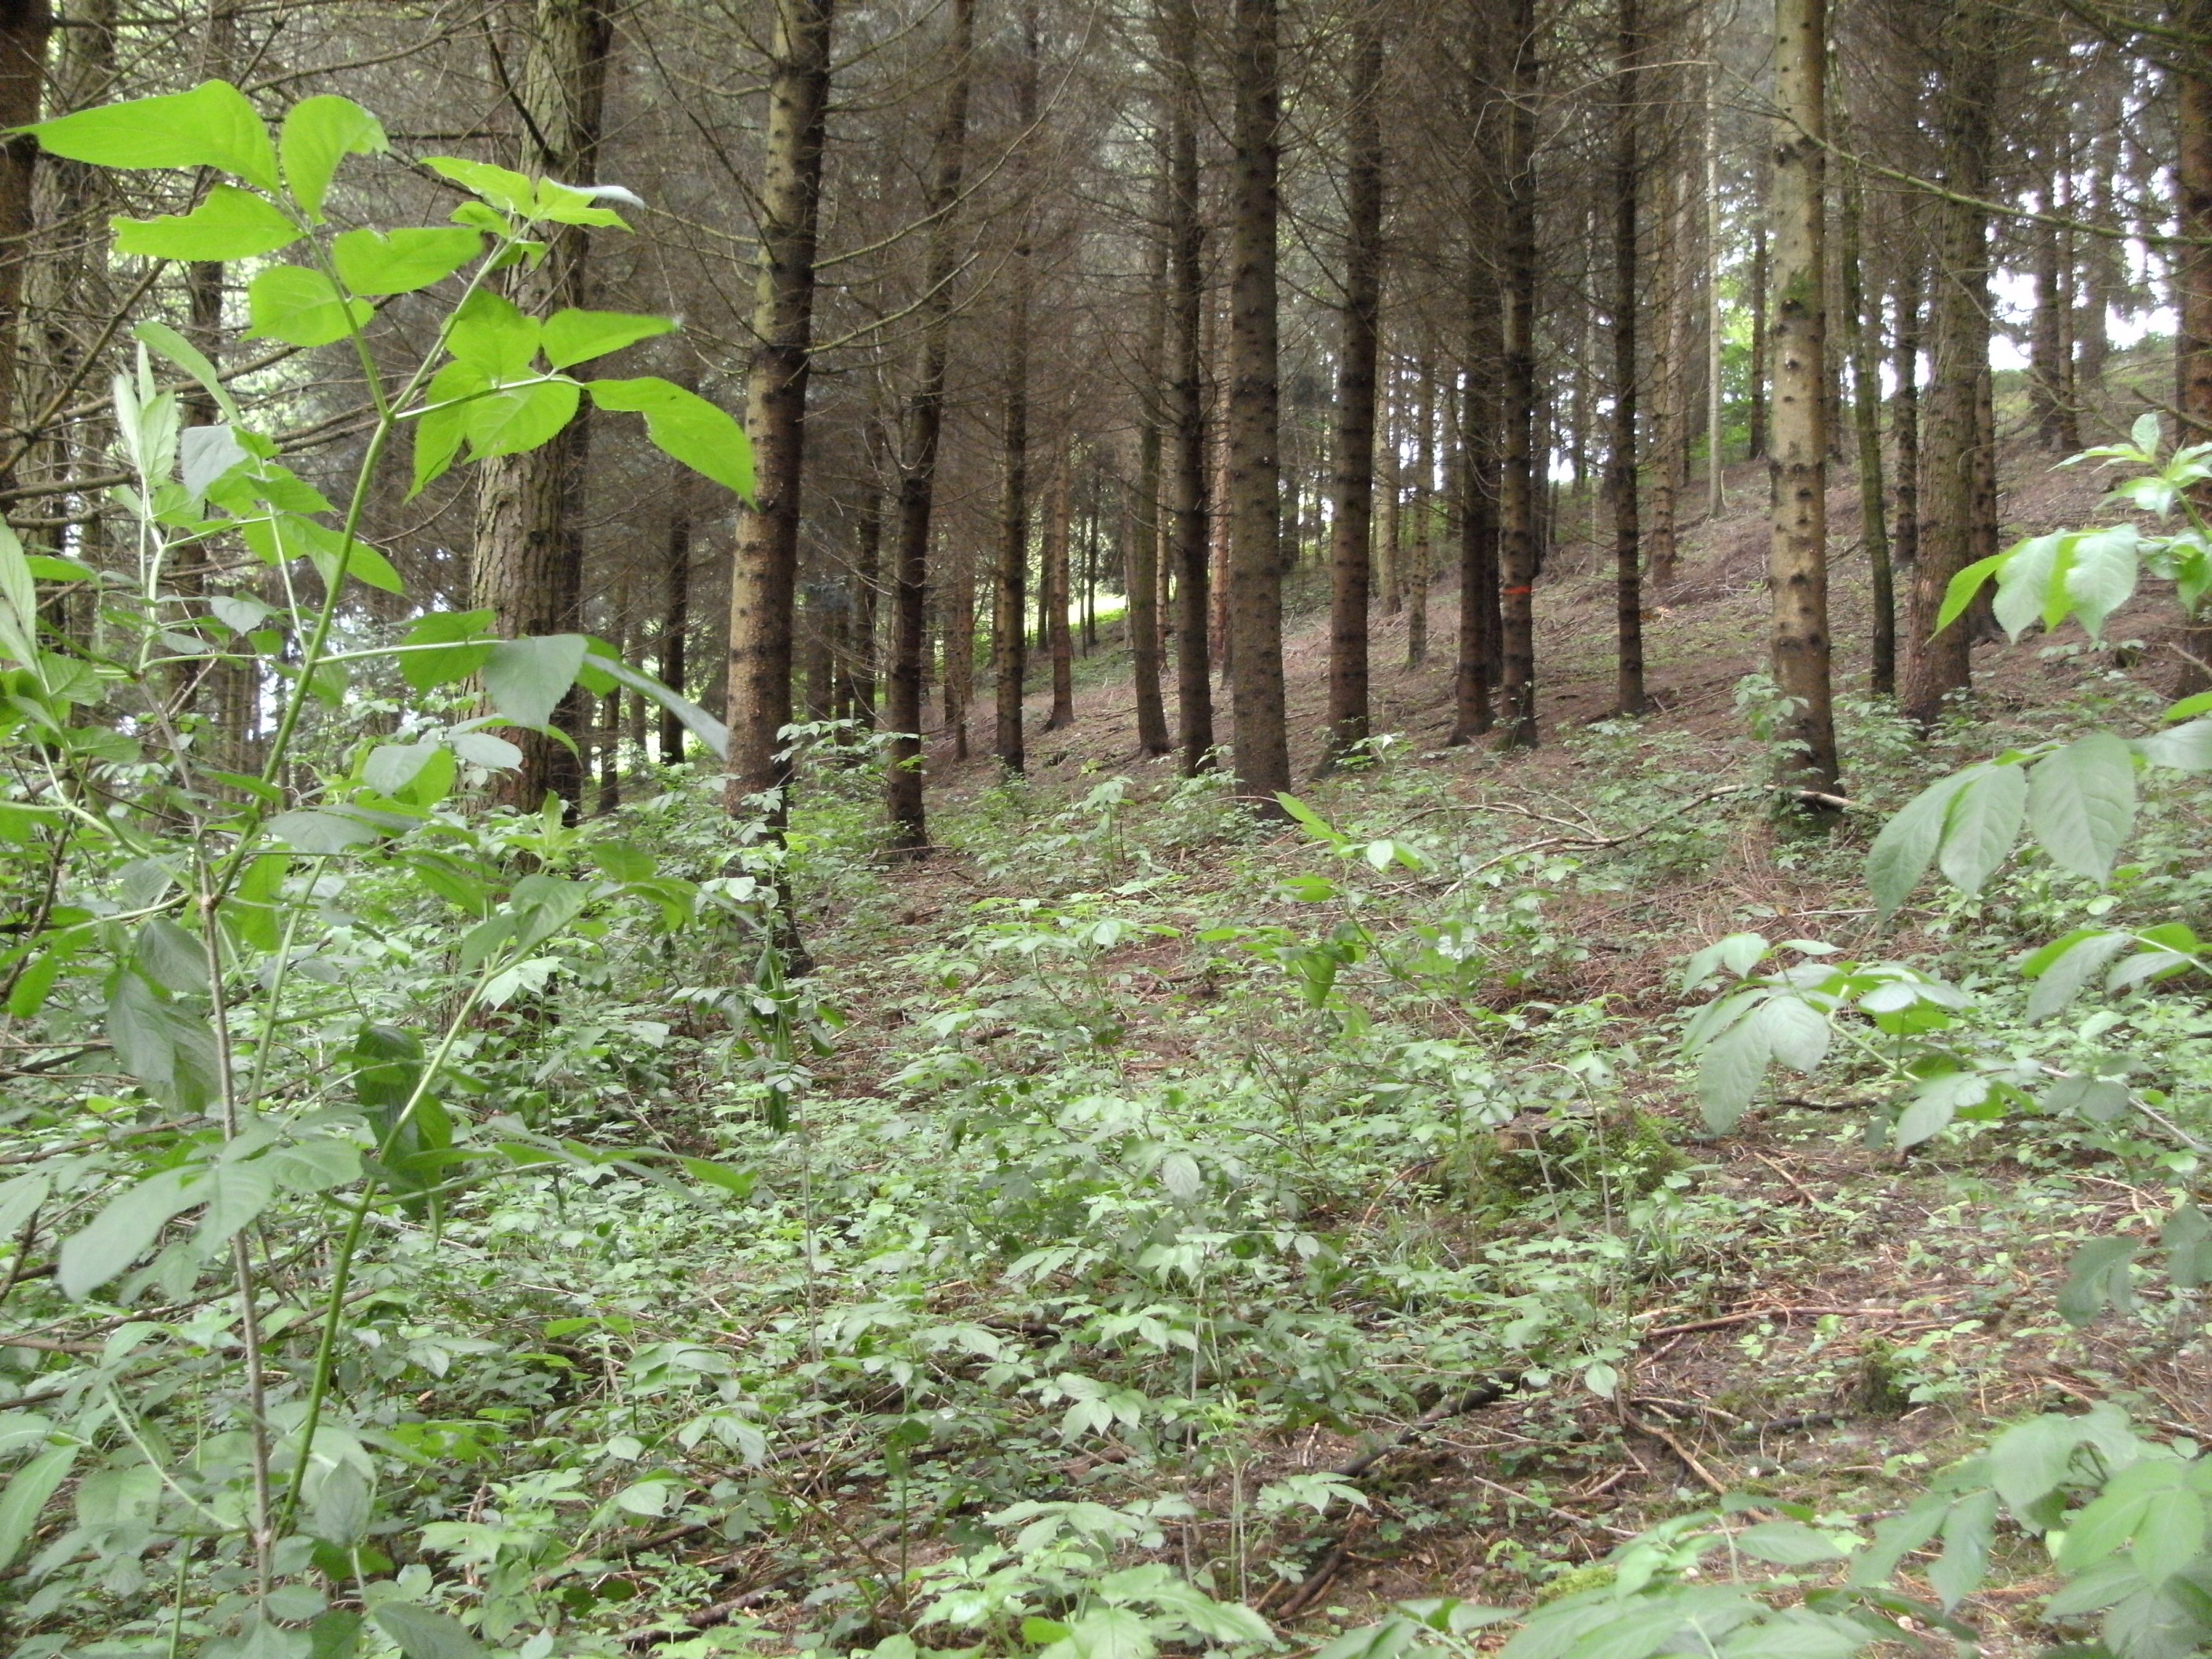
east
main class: Woodland
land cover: Other mixed woodland
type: hemiboreal forest and nemoral coniferous forest and mixed broadleaved-coniferous forest
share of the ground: > 75 %
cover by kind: coniferous forest trees 60 %, broadleaved forest trees 30 %, shrubs 5 %, herbaceous plants 5 %
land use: Forestry
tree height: > 5 m
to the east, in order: Other mixed woodland; Other coniferous woodland; Tracks; Other coniferous woodland; Broadleaved woodland; Paved roads, cycling and walking lanes; Ditches and canals; Apple fruit; Maize
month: May
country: AT
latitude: 48.1314
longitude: 14.0441
